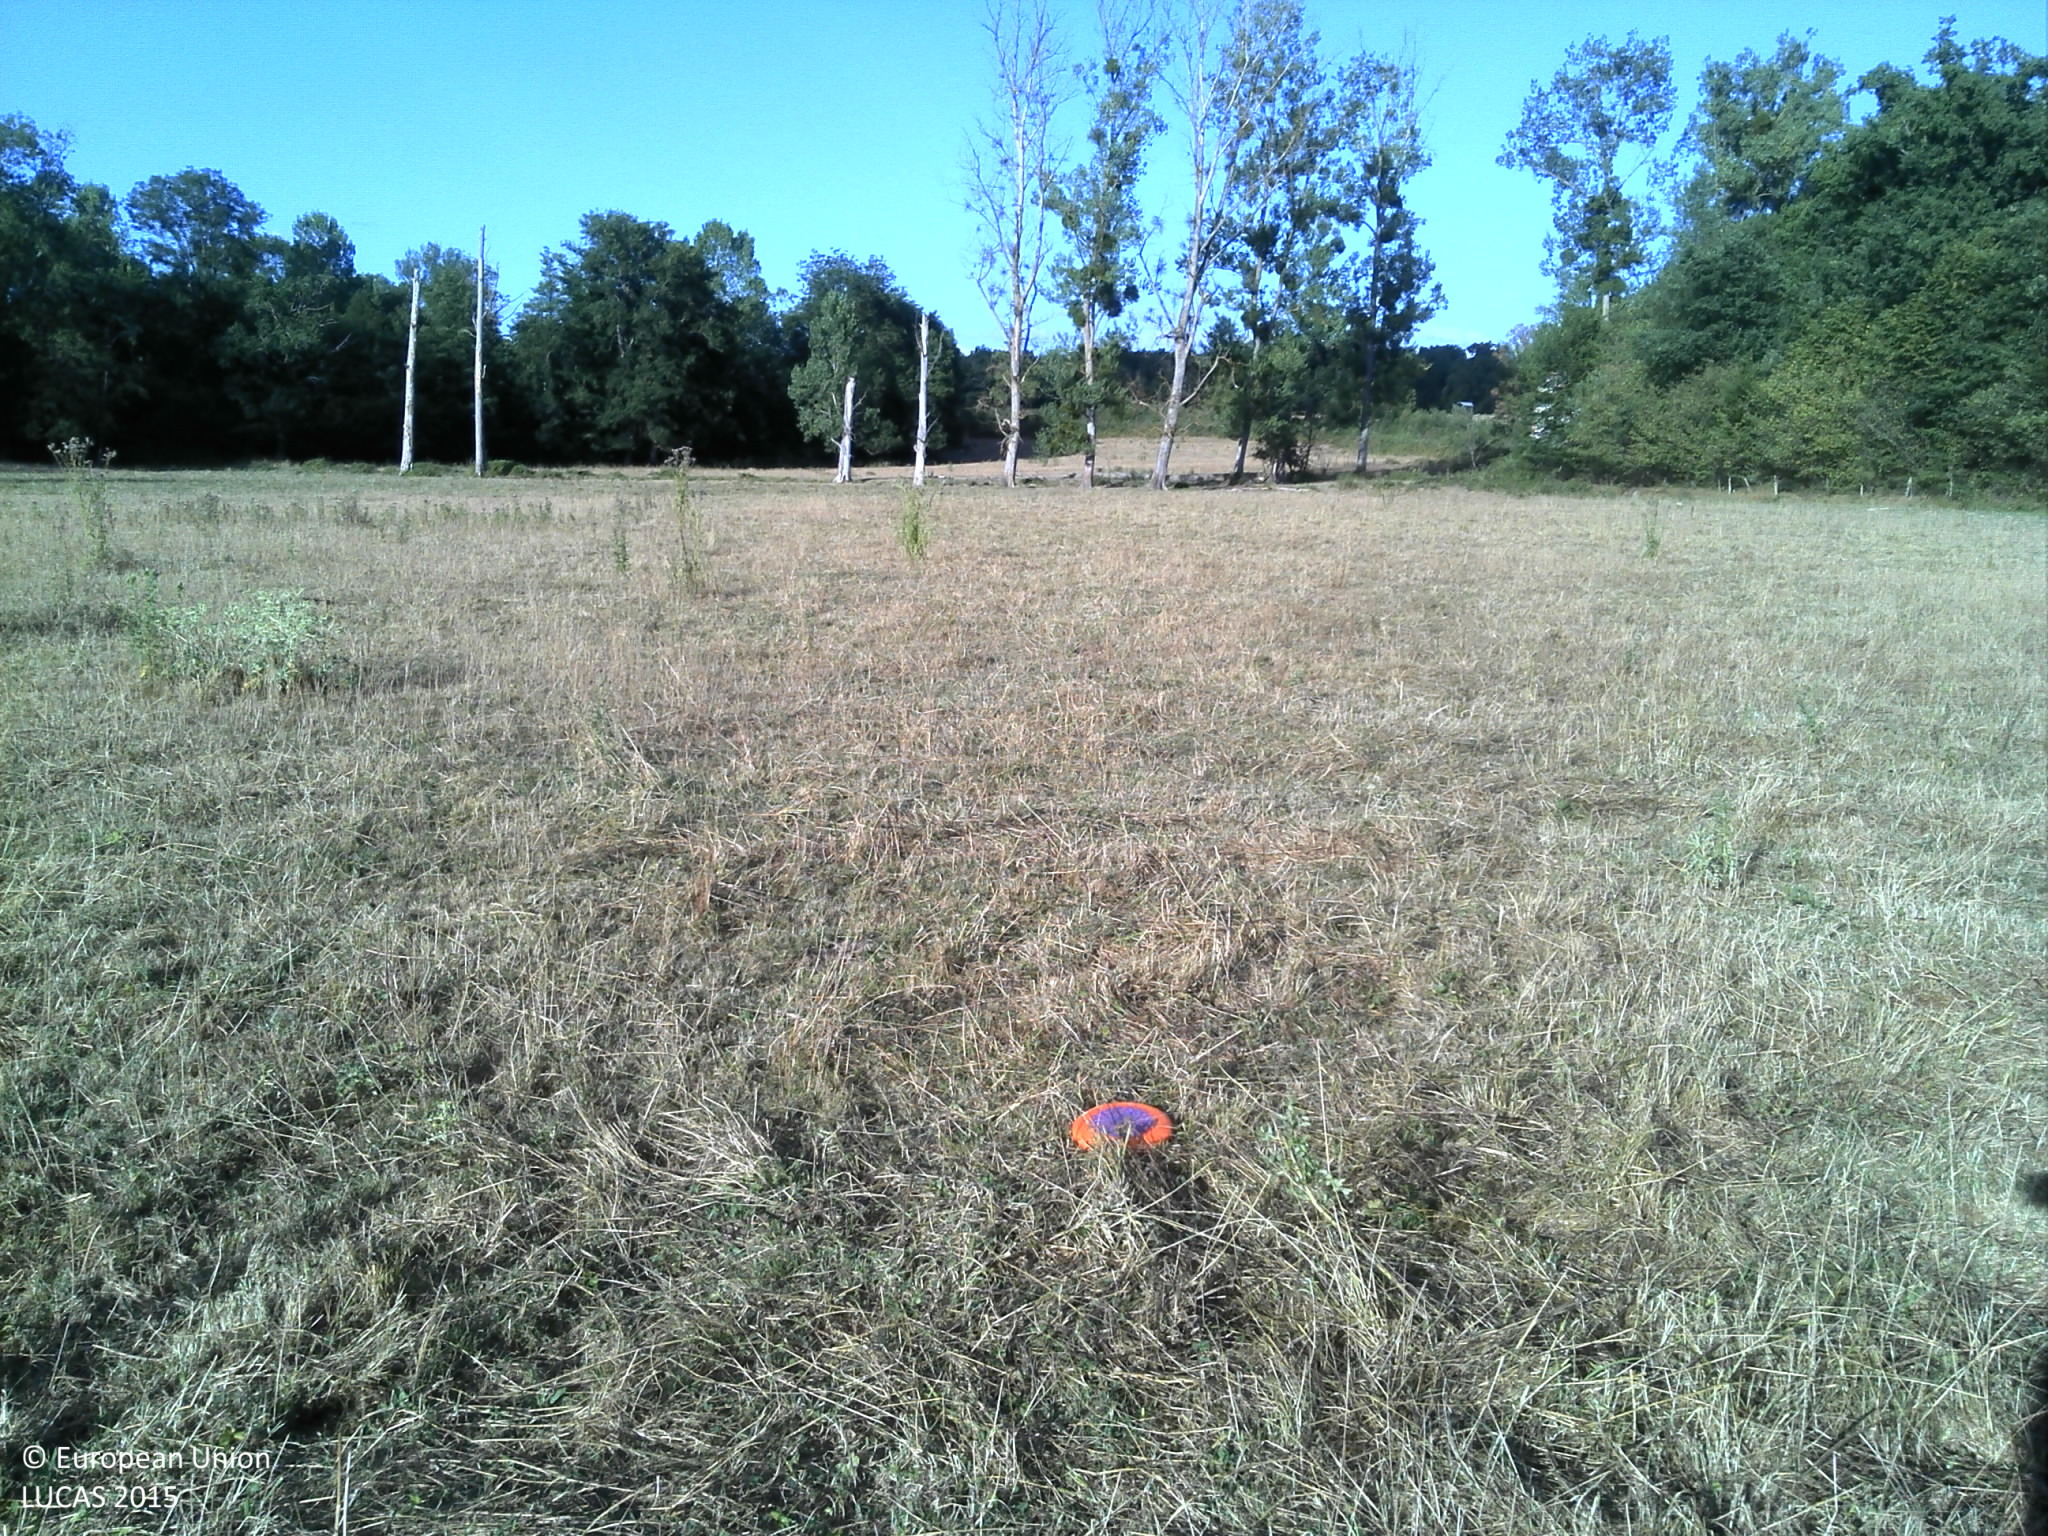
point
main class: Grassland
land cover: Grassland without tree/shrub cover
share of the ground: > 75 %
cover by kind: herbaceous plants 100 %
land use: Agriculture (excluding fallow land and kitchen gardens)
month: July
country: FR
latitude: 45.8282
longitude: 4.1195
